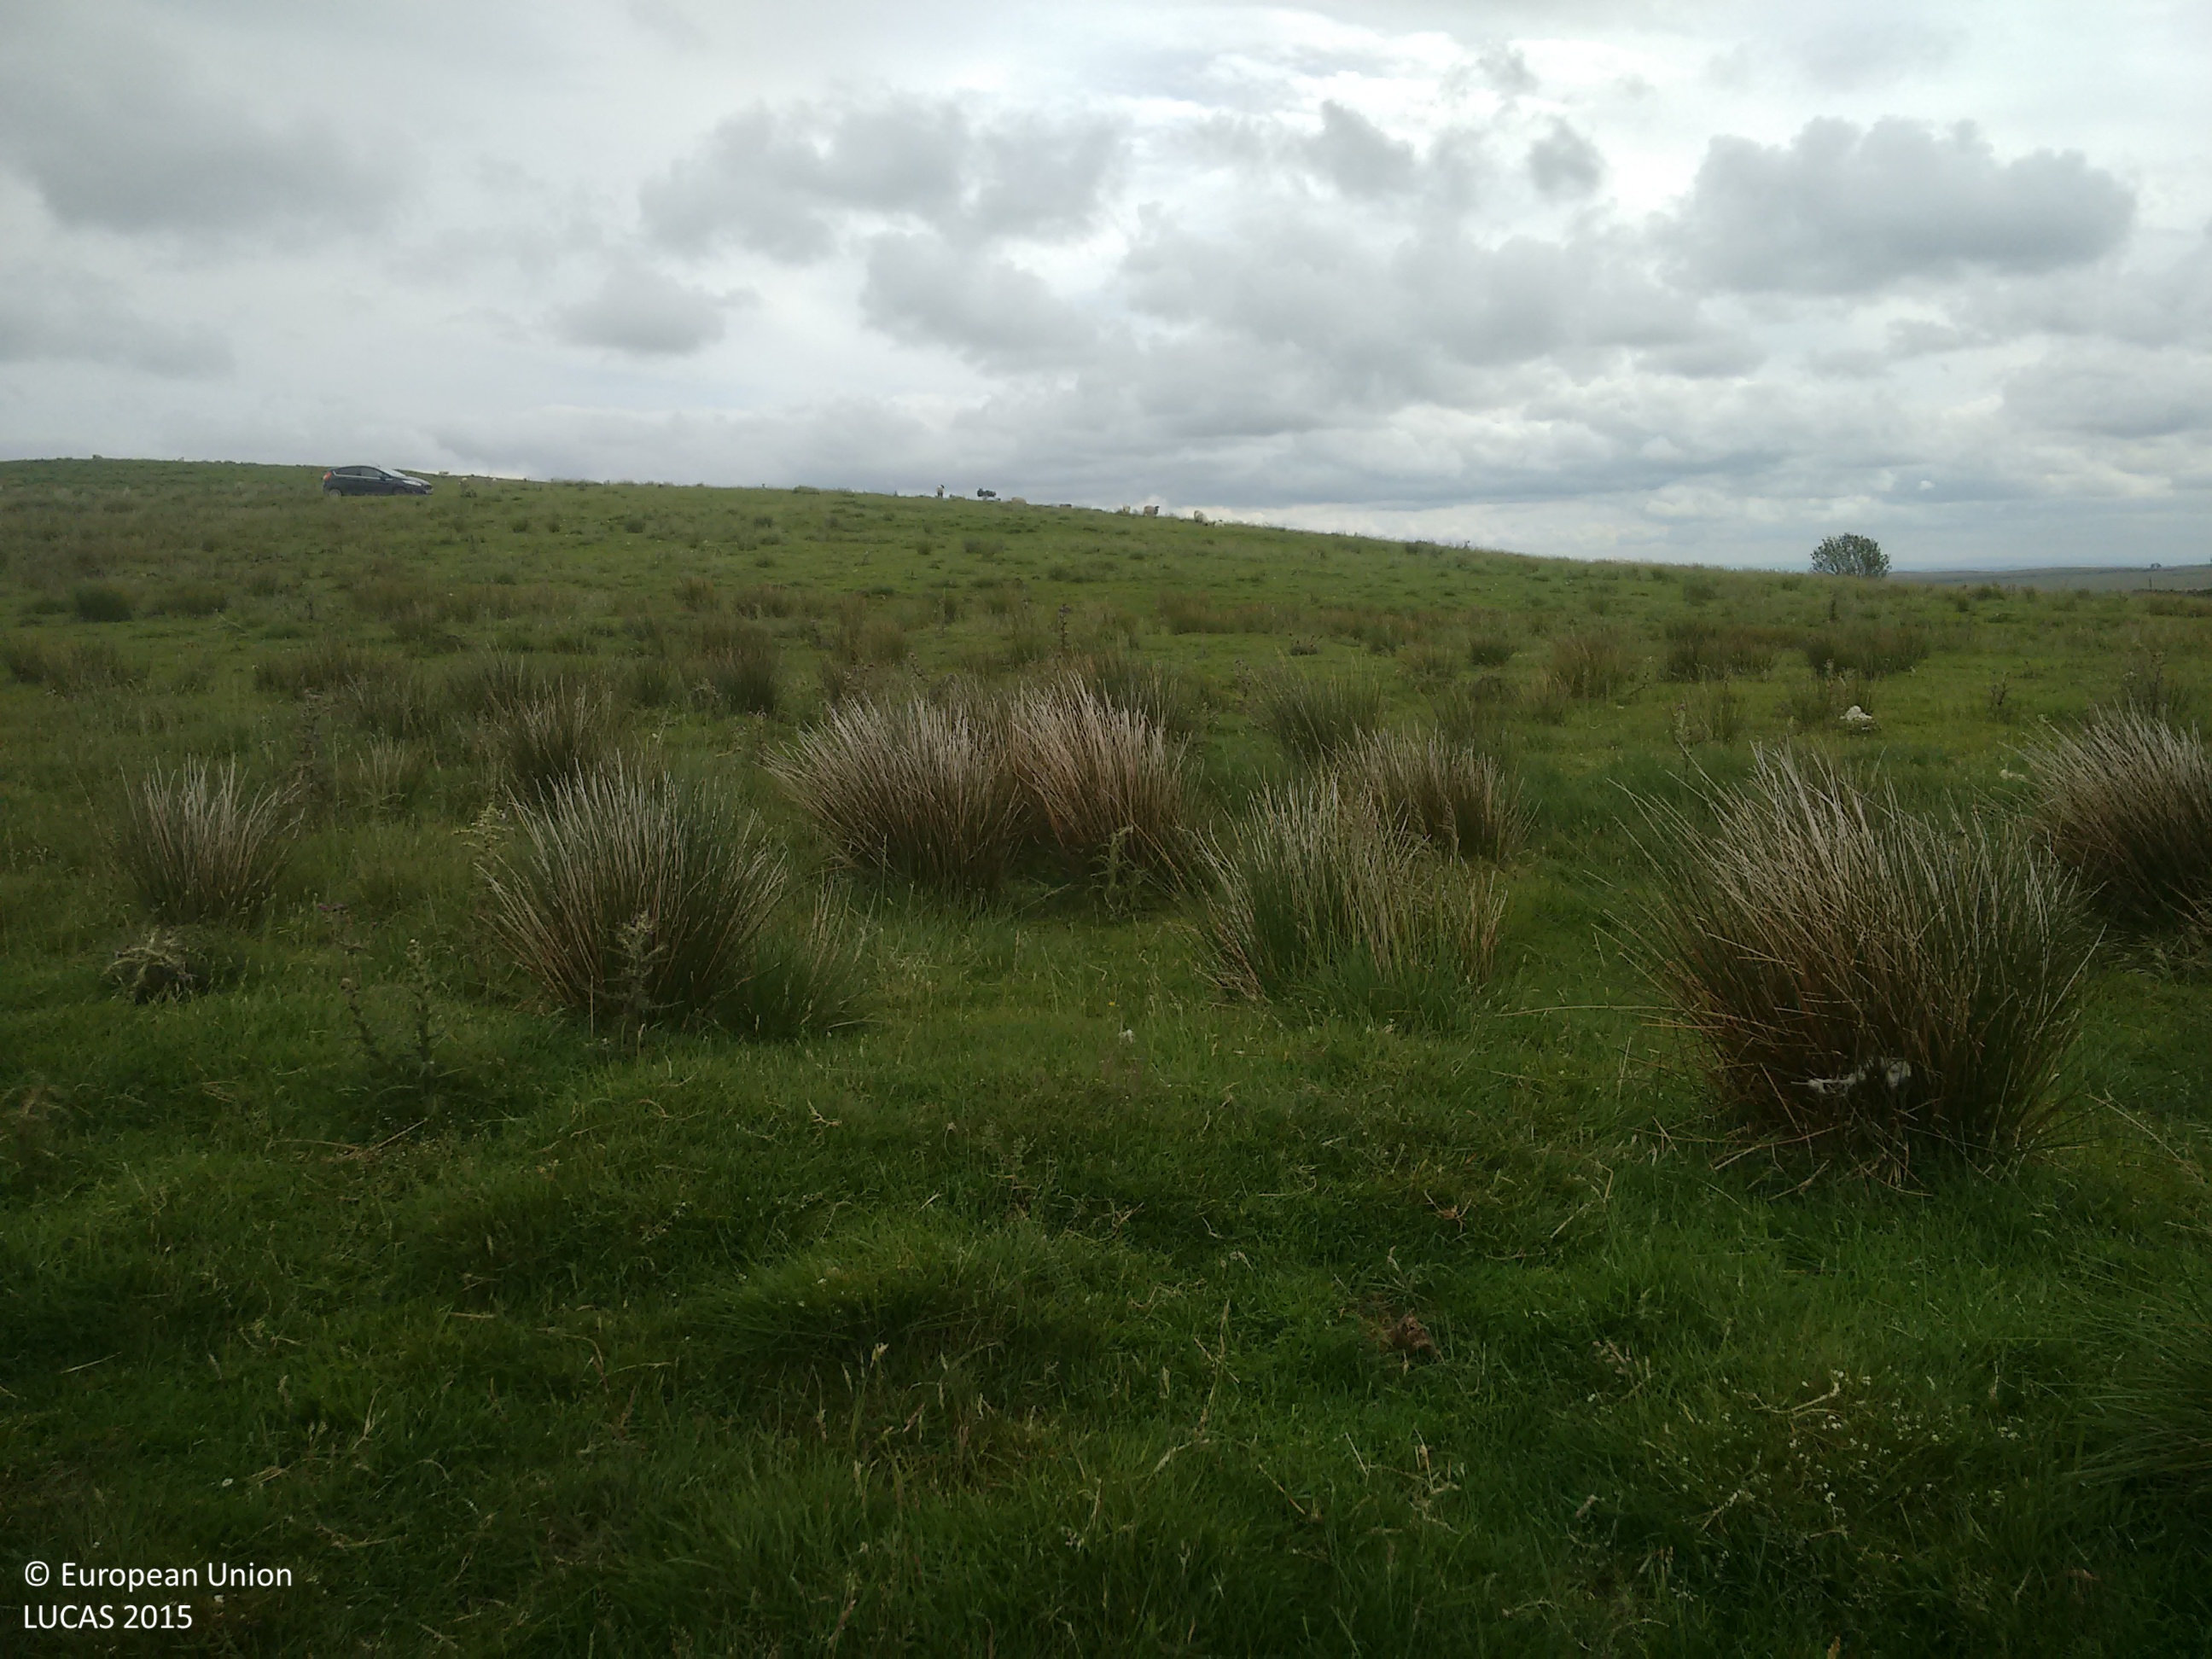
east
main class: Grassland
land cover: Grassland without tree/shrub cover
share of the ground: > 75 %
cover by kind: herbaceous plants 100 %
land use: Agriculture (excluding fallow land and kitchen gardens)
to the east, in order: Grassland without tree/shrub cover; Dry stone walls; Grassland without tree/shrub cover
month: July
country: GB
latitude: 54.5745
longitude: -2.1081
